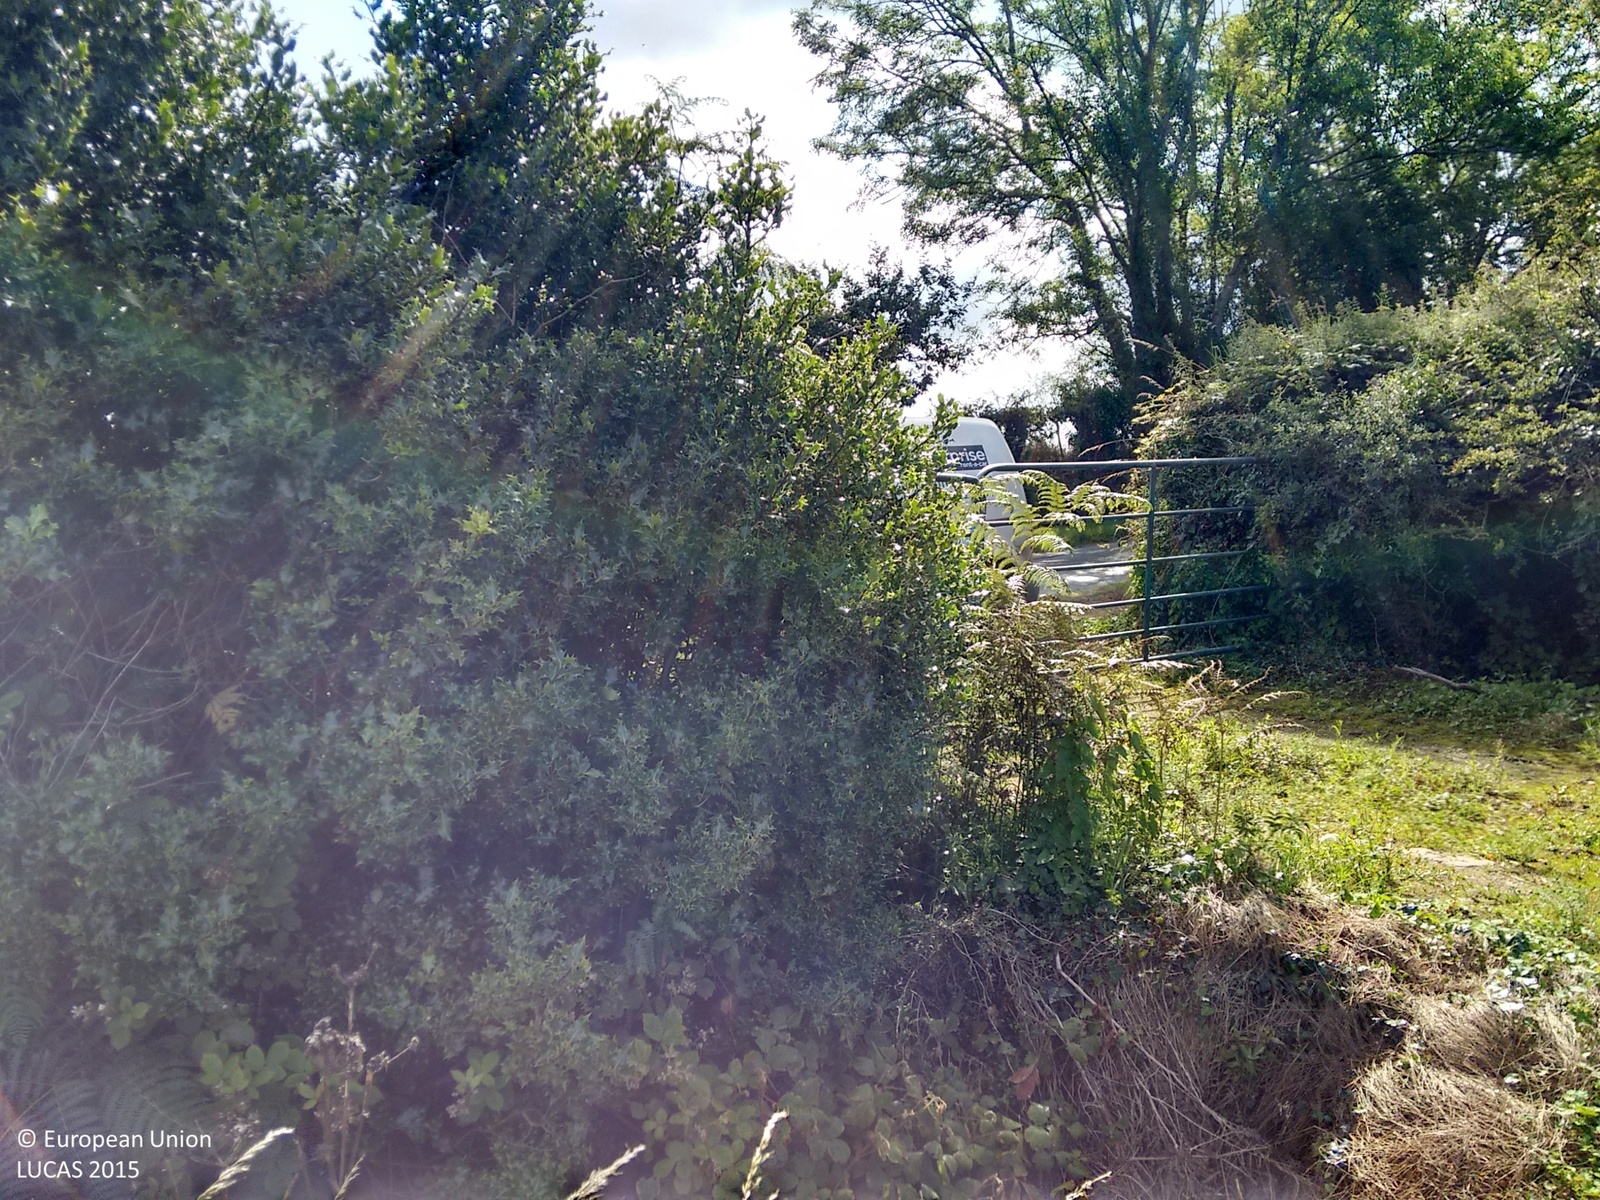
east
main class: Cropland
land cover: Dry pulses
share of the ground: > 75 %
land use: Agriculture (excluding fallow land and kitchen gardens)
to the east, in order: Dry pulses; Grass margins; Ditches and canals; Abandoned hedges; Ditches and canals; Grass margins; Paved roads, cycling and walking lanes; Grass margins; Ditches and canals; Abandoned hedges; Barley
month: August
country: IE
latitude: 52.5360
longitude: -6.3554
